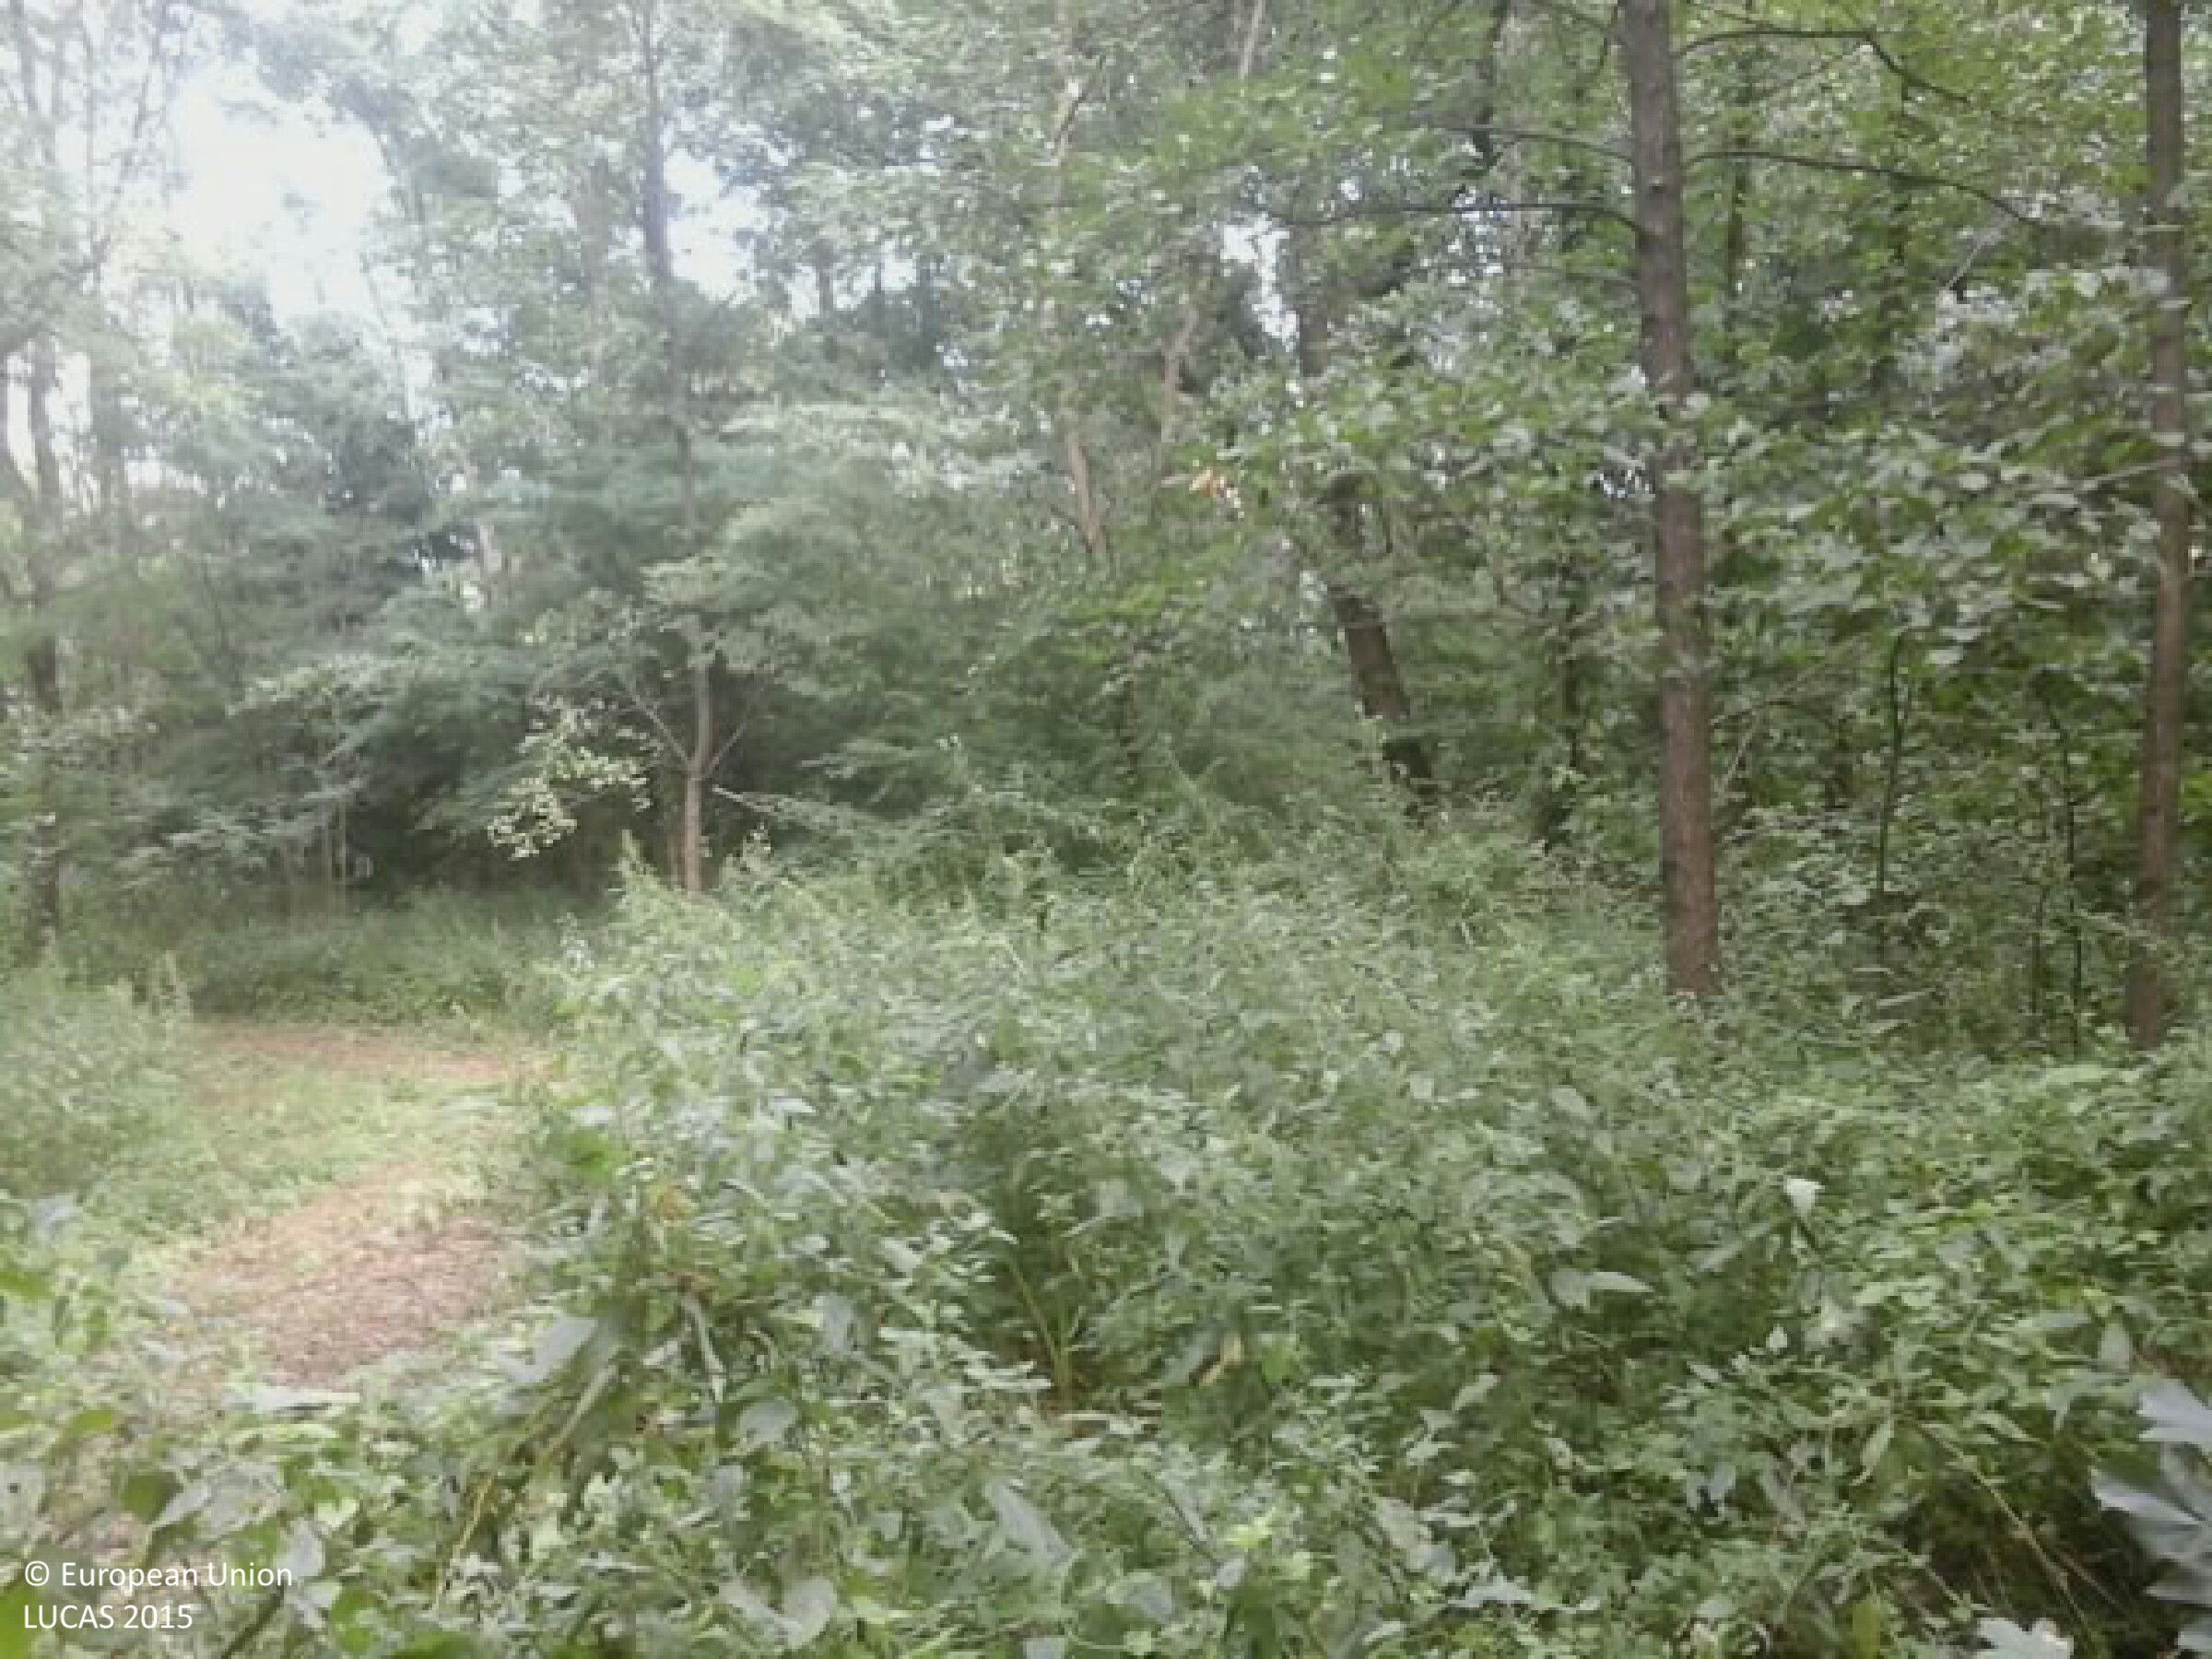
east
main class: Woodland
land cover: Broadleaved woodland
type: mesophytic deciduous forest
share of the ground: > 75 %
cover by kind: broadleaved forest trees 95 %, herbaceous plants 5 %
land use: Forestry
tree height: > 5 m
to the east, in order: Broadleaved woodland; Tracks; Broadleaved woodland; Spontaneously vegetated surfaces; Inland fresh water bodies; Grass margins; Inland fresh water bodies; Grassland without tree/shrub cover; Paved roads, cycling and walking lanes; Grassland without tree/shrub cover; Ditches and canals; Grass margins; Tracks; Grassland without tree/shrub cover; Broadleaved woodland
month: August
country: HU
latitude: 46.2120
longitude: 18.2646
